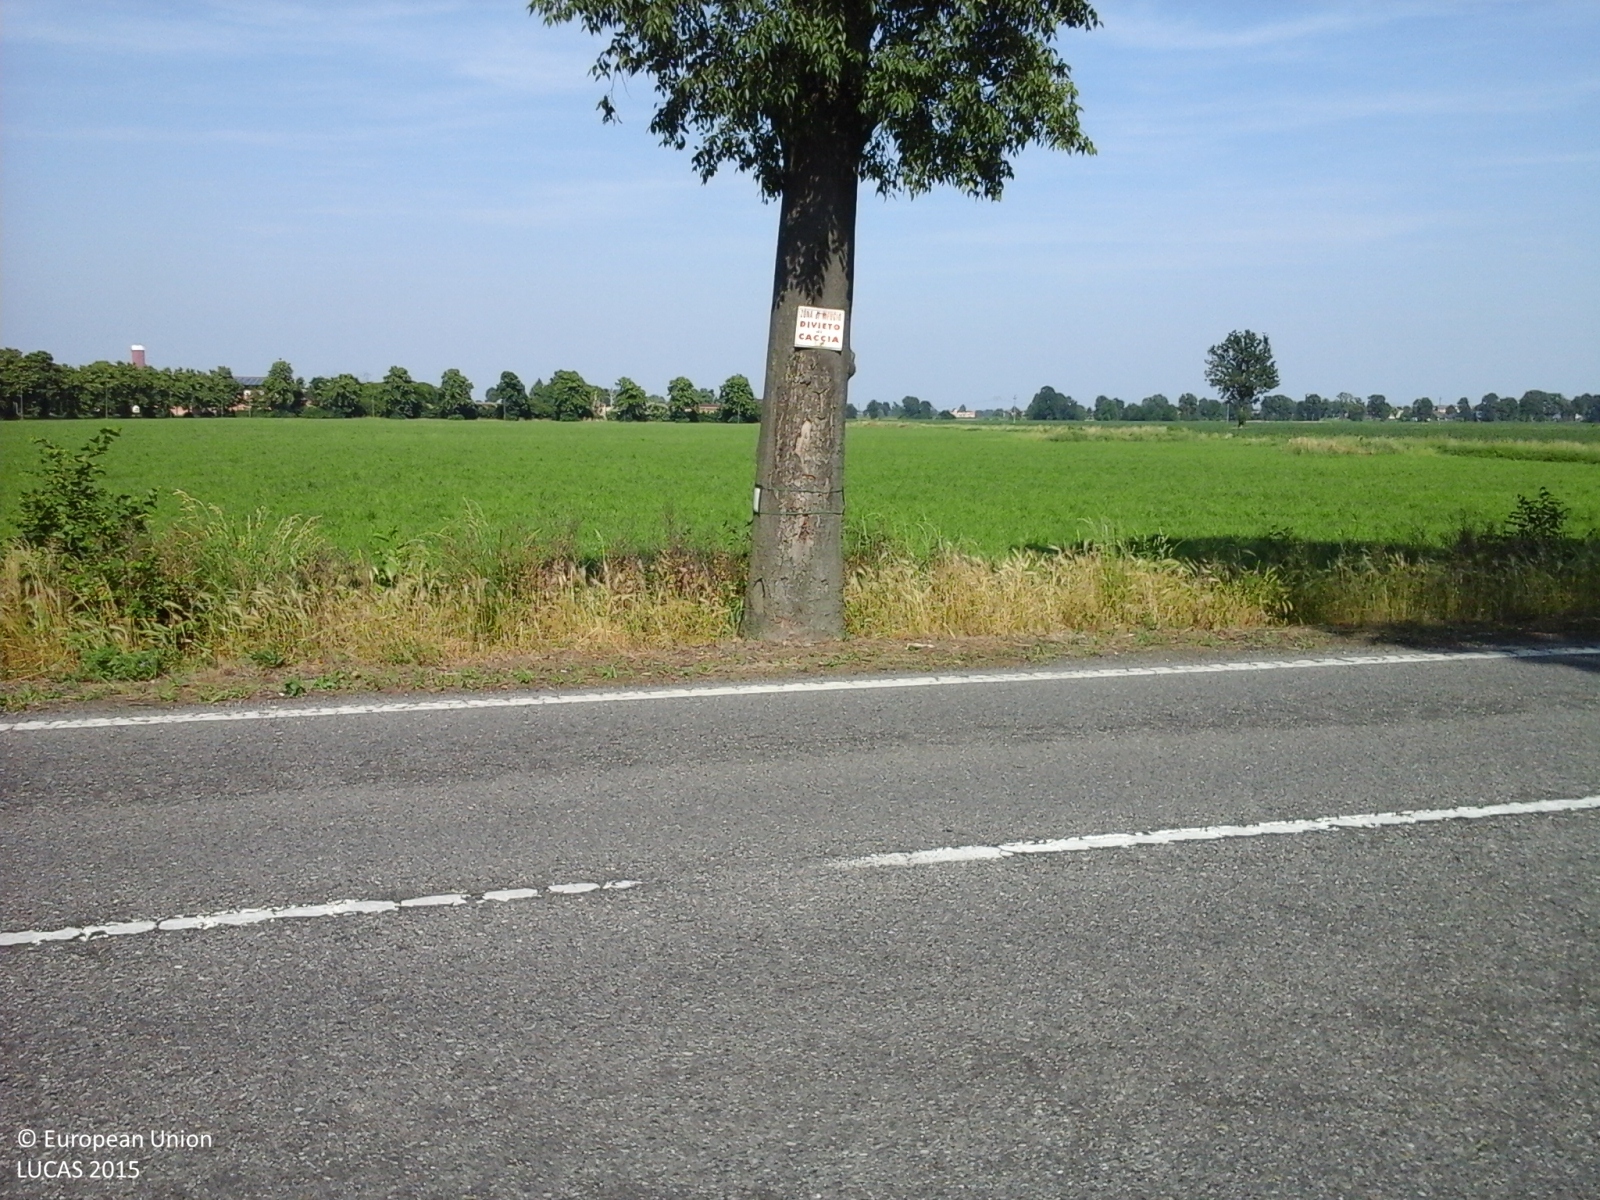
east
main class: Cropland
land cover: Temporary grasslands
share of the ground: > 75 %
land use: Agriculture (excluding fallow land and kitchen gardens)
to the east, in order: Temporary grasslands; Ditches and canals; Lines of trees; Paved roads, cycling and walking lanes; Lines of trees; Ditches and canals; Temporary grasslands
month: May
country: IT
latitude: 45.2153
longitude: 9.6060
